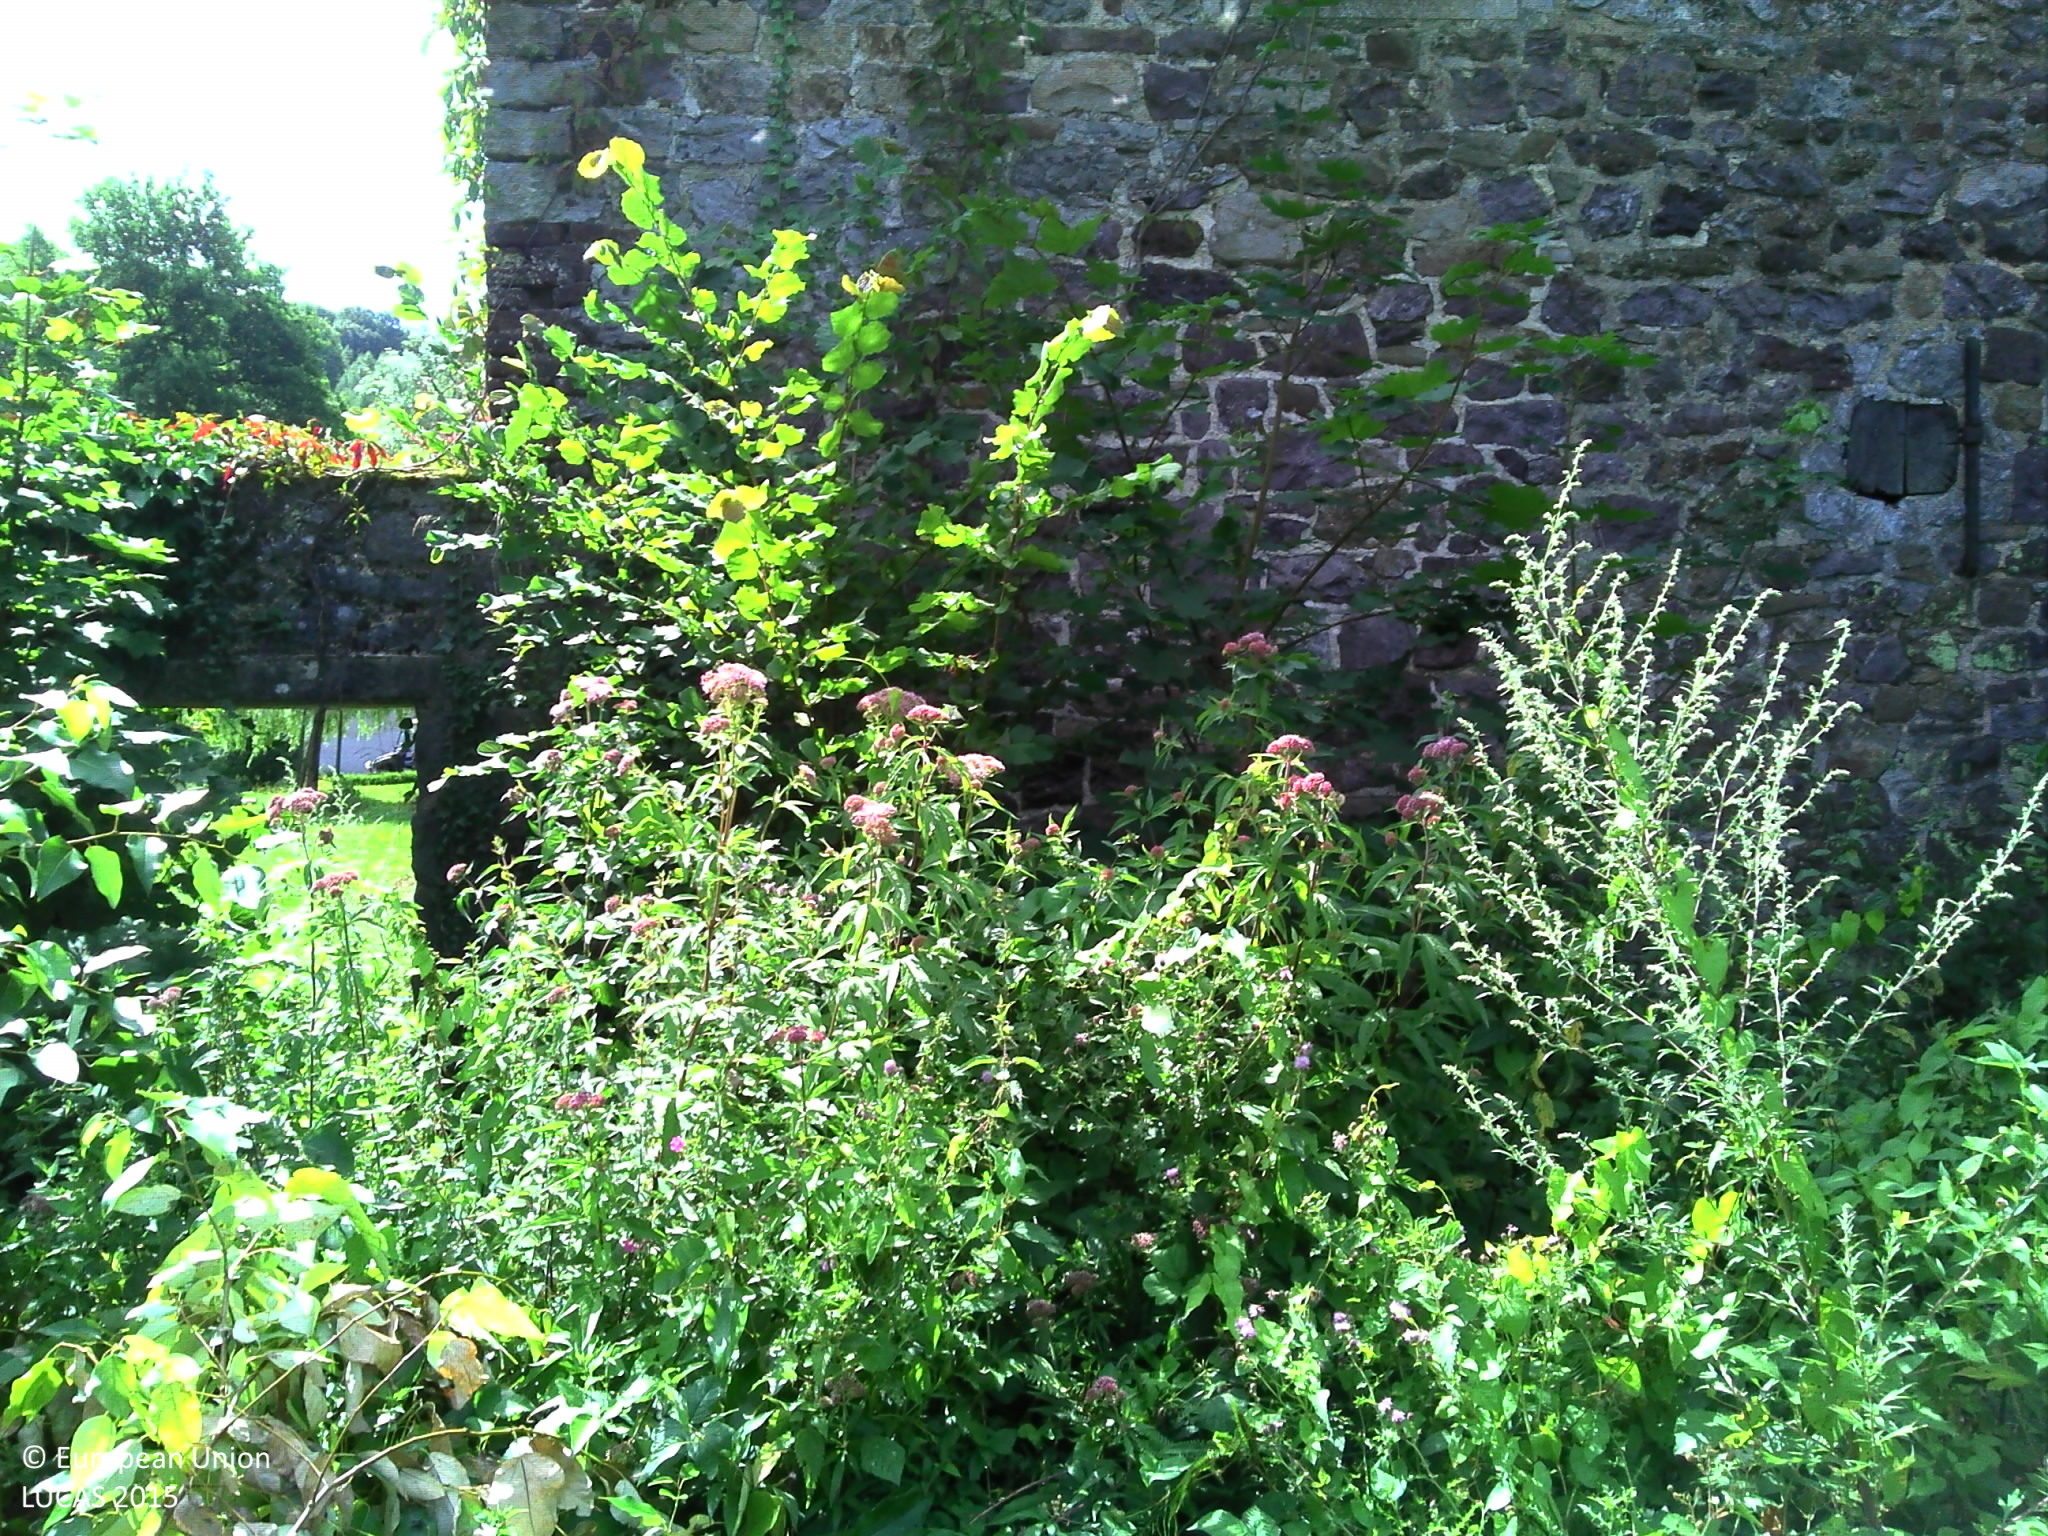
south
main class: Shrubland
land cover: Shrubland with sparse tree cover
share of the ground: > 75 %
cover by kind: shrubs 50 %, herbaceous plants 45 %, broadleaved forest trees 5 %
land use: Semi-natural and natural areas not in use
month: August
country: BE
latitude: 50.3620
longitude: 4.5841
